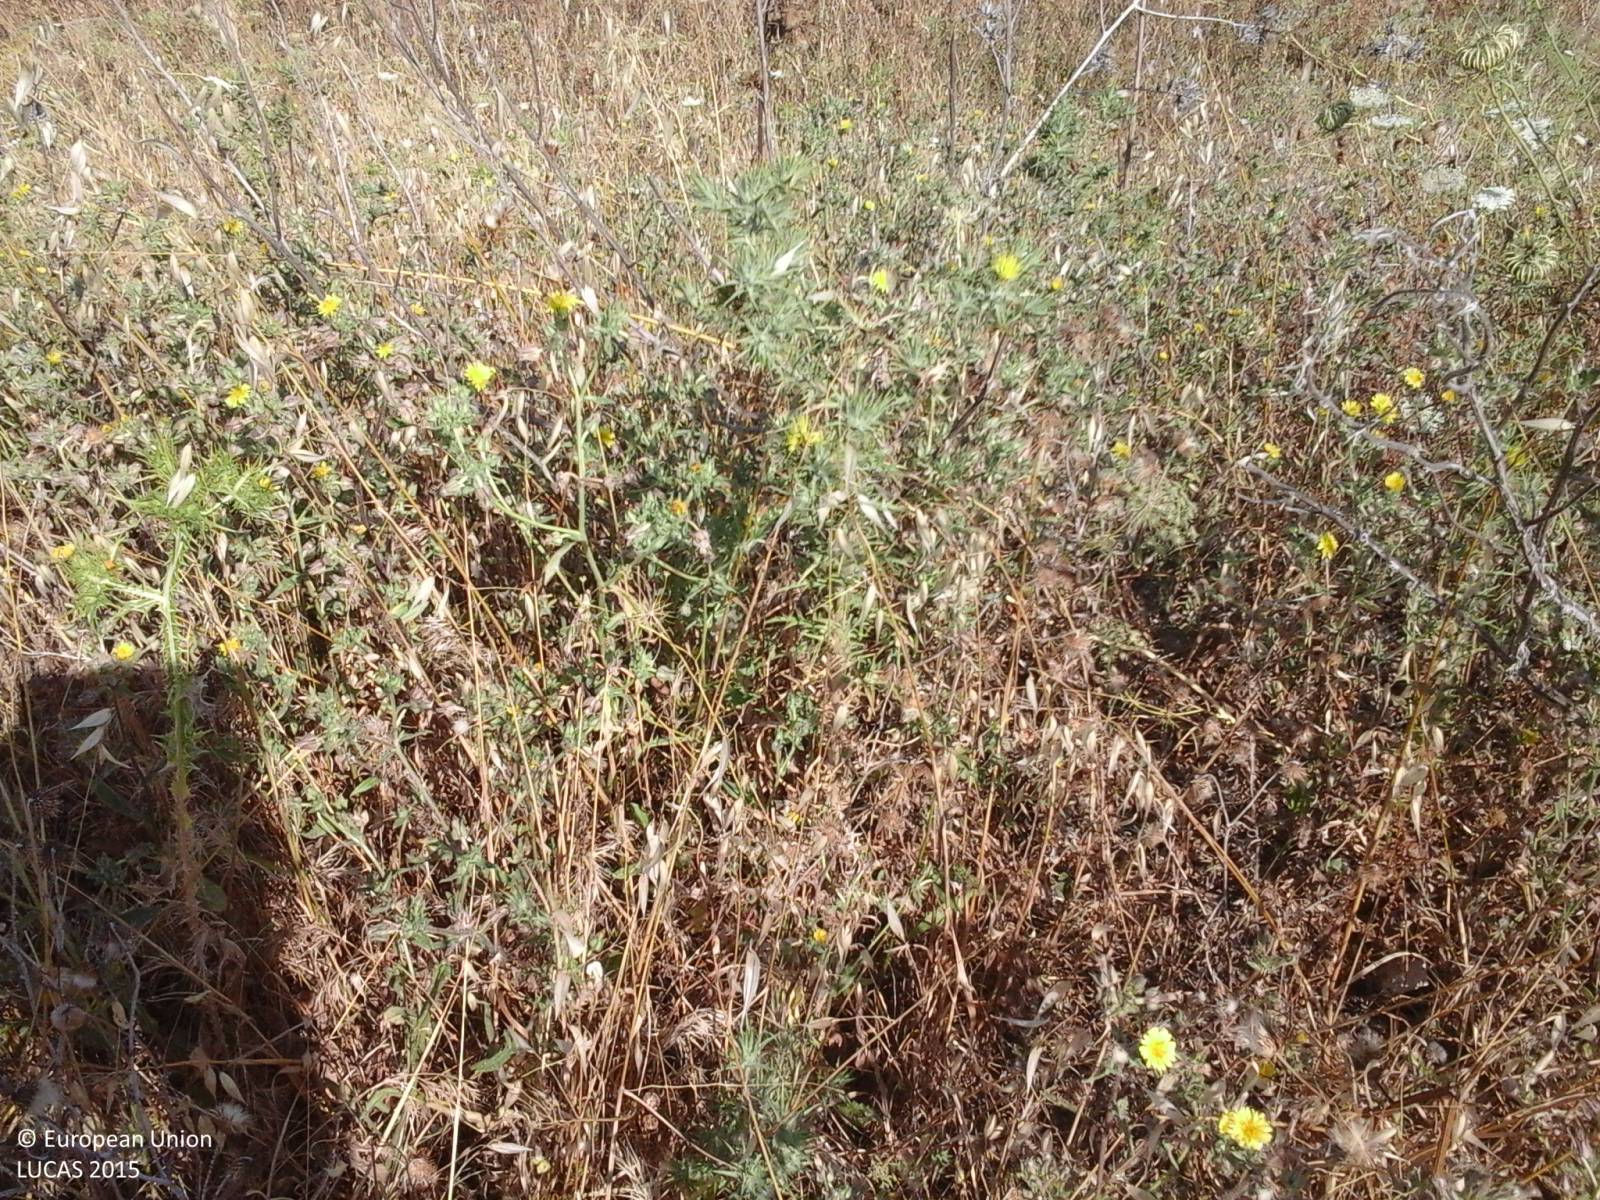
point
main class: Grassland
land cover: Spontaneously vegetated surfaces
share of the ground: > 75 %
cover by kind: herbaceous plants 95 %, shrubs 5 %
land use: Semi-natural and natural areas not in use
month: July
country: IT
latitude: 37.8437
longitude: 13.0572
